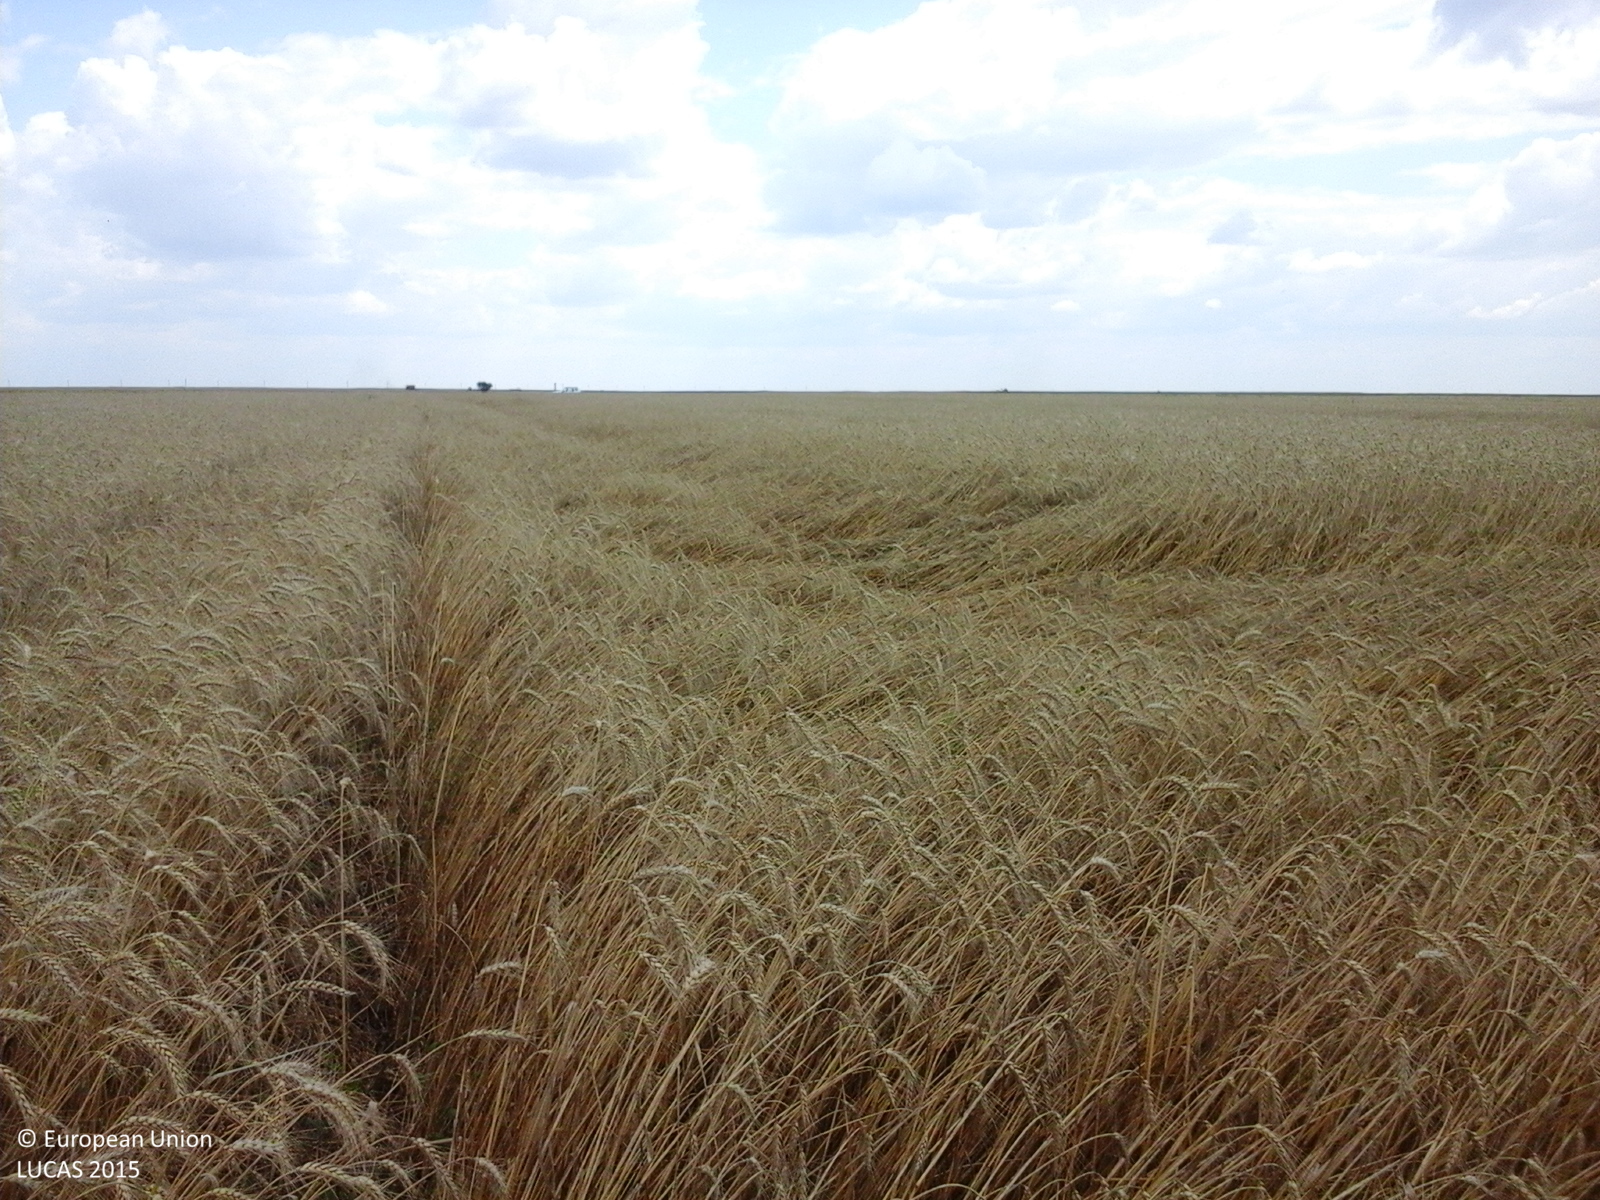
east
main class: Cropland
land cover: Common wheat
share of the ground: > 75 %
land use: Agriculture (excluding fallow land and kitchen gardens)
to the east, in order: Common wheat; Grass margins; Tracks; Grass margins; Common wheat
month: July
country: RO
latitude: 44.0072
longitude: 24.7259
